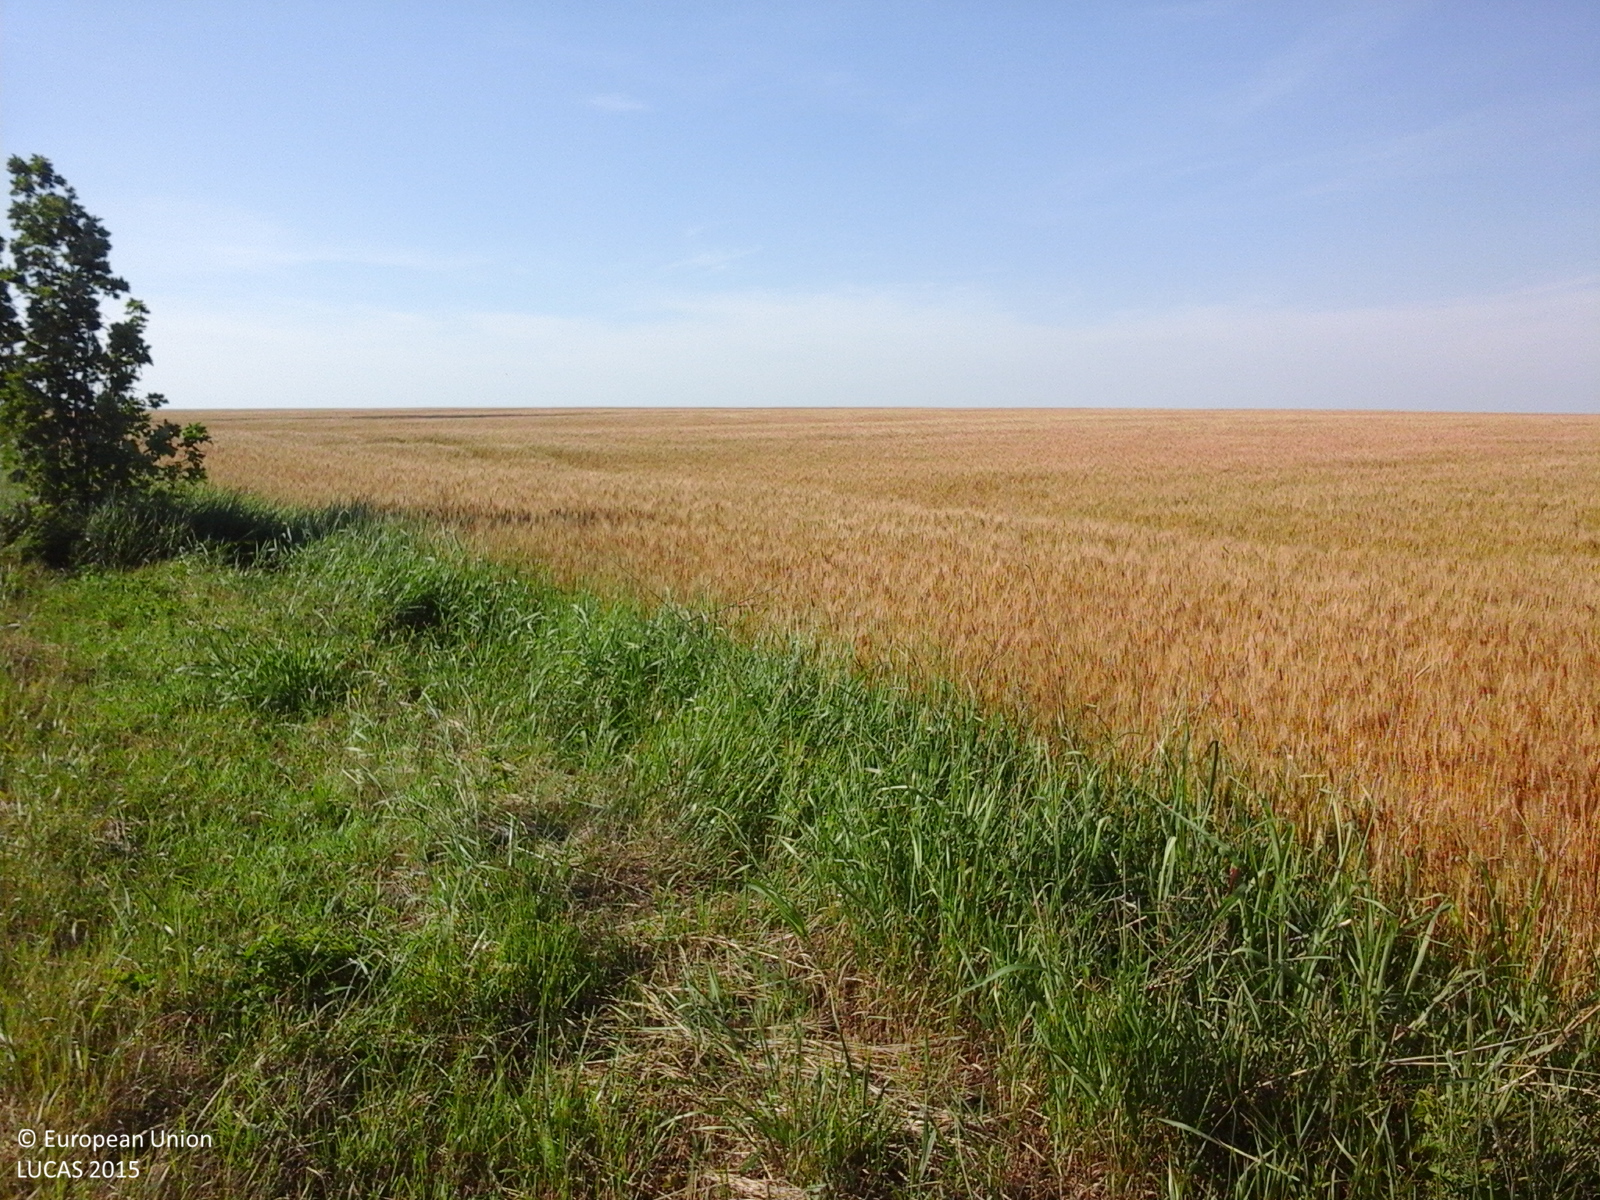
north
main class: Cropland
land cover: Common wheat
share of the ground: > 75 %
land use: Agriculture (excluding fallow land and kitchen gardens)
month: June
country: RO
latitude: 47.8939
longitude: 27.1641
